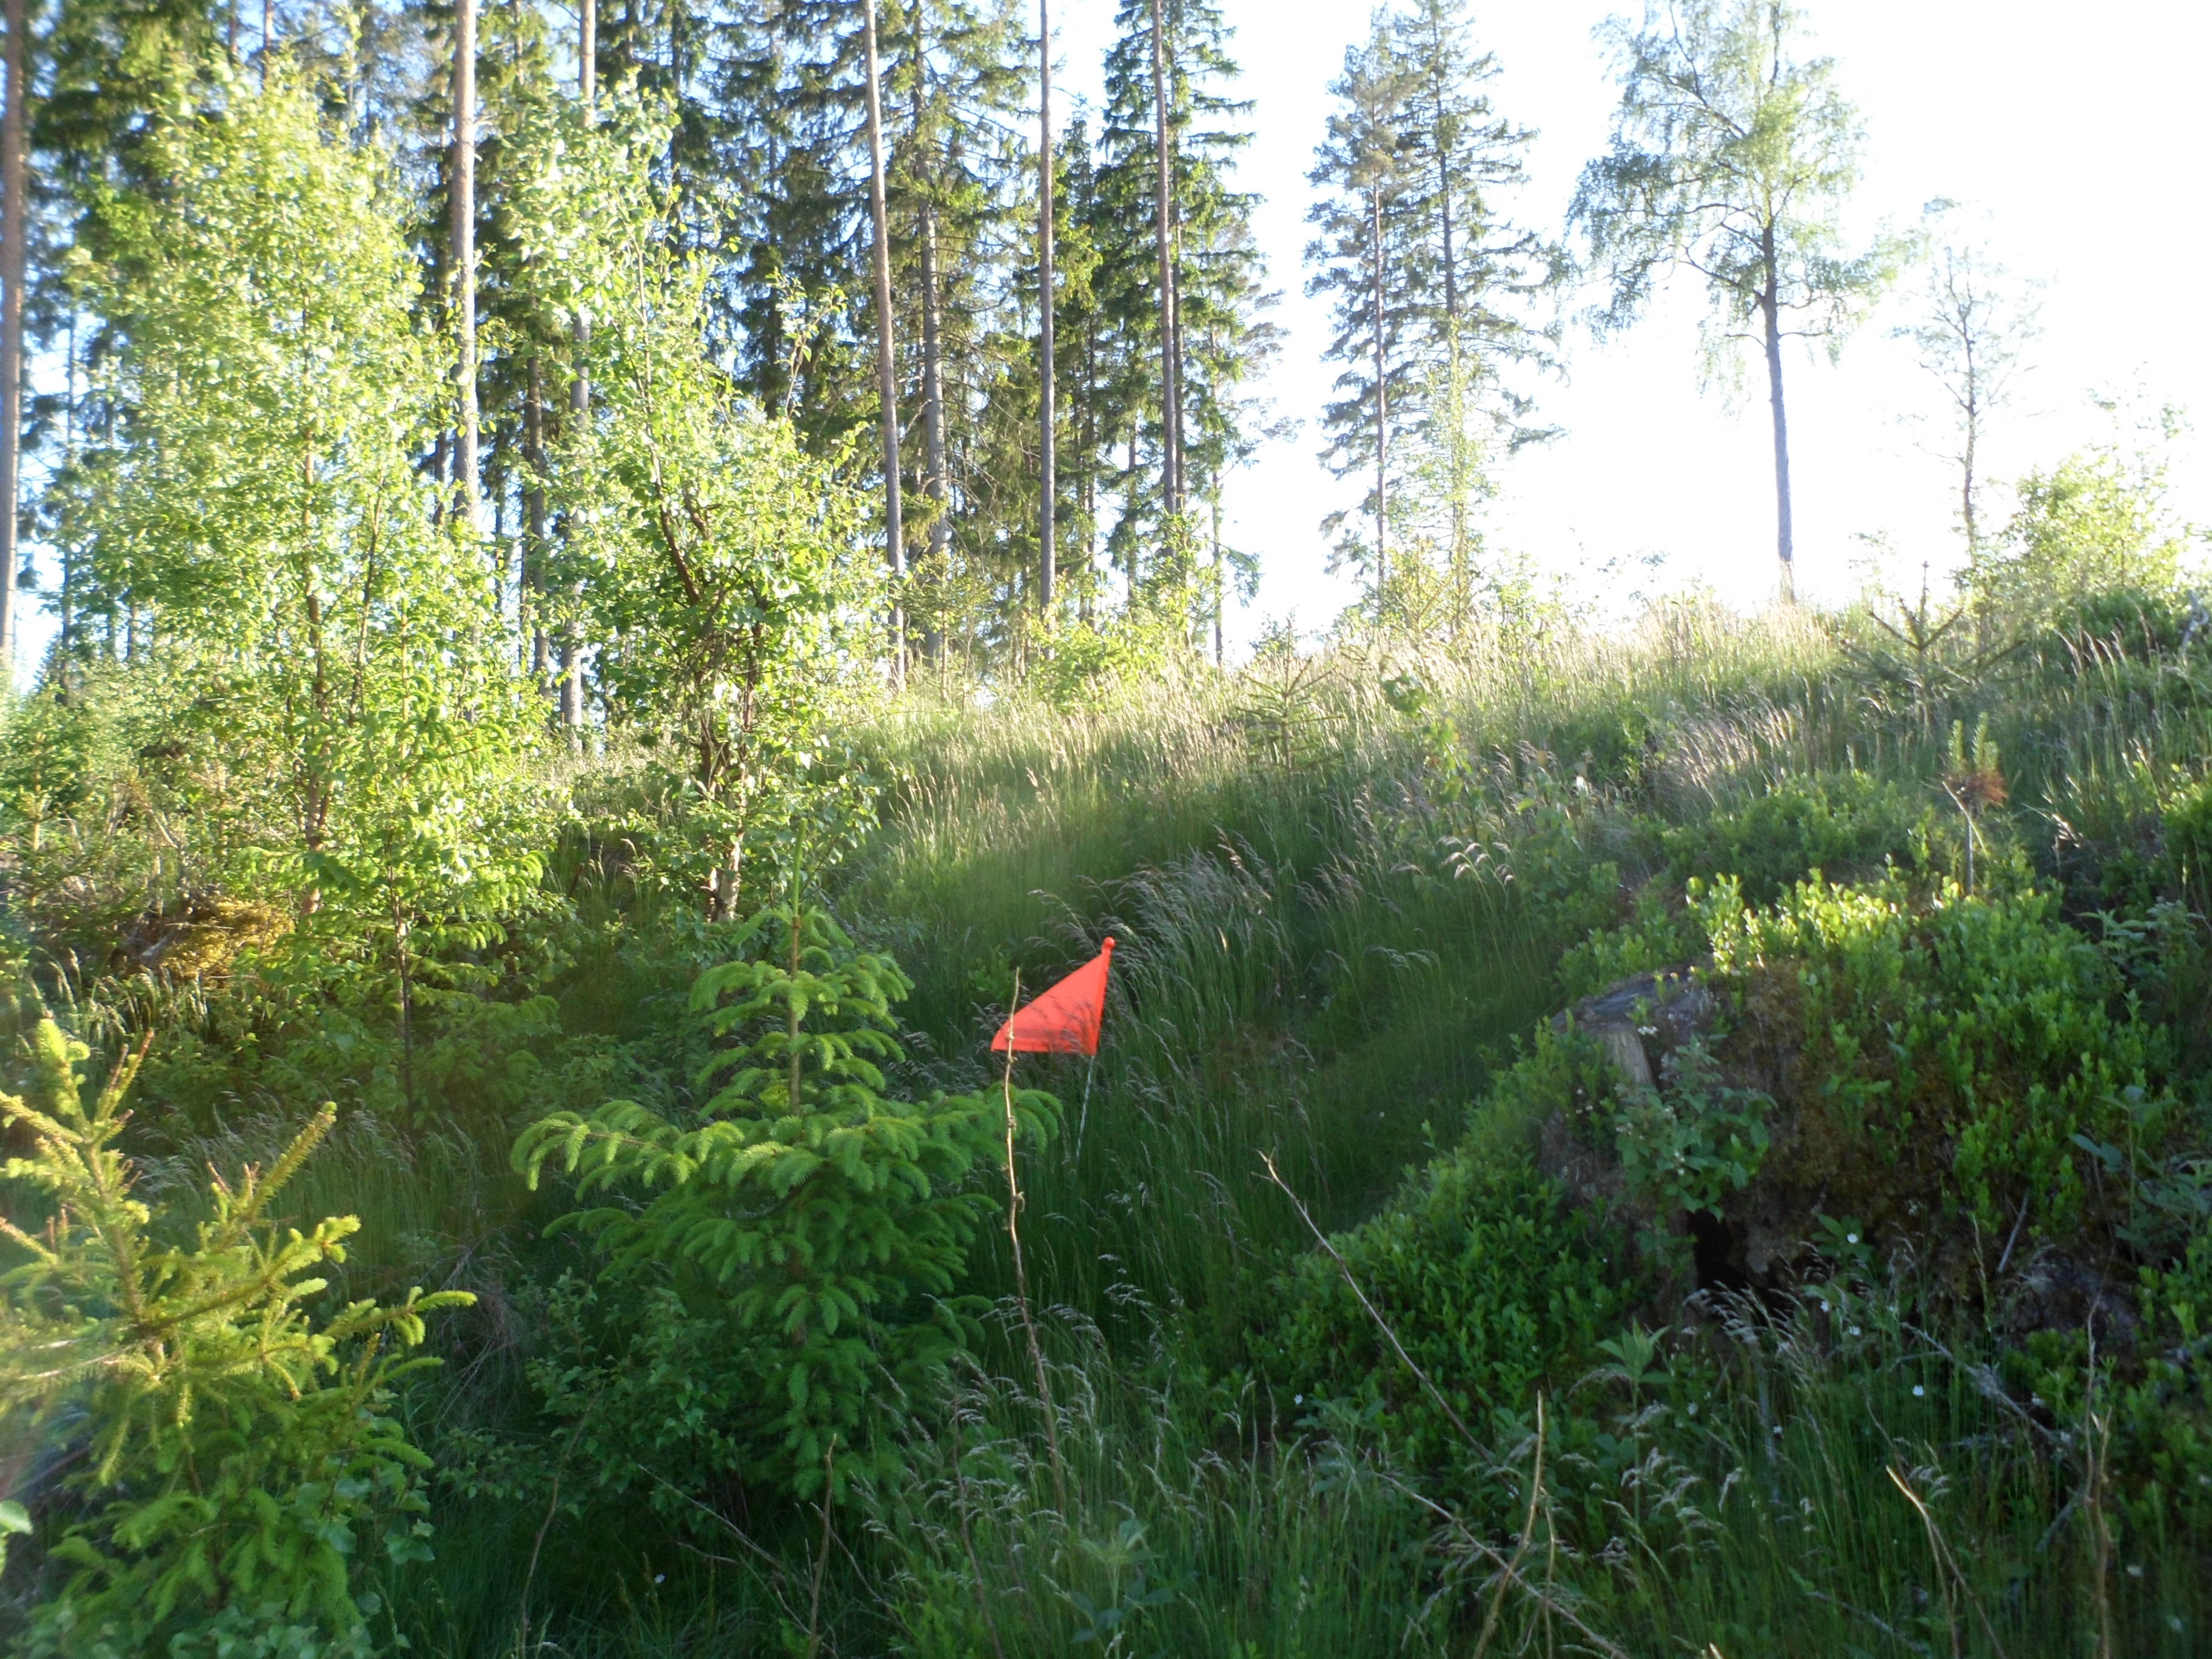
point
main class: Woodland
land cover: Spruce dominated mixed woodland
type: boreal forest
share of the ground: 50 - 75 %
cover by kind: coniferous forest trees 25 %, broadleaved forest trees 25 %, herbaceous plants 25 %, shrubs 20 %, lichens and mosses 5 %
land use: Forestry
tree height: < 5 m
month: June
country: SE
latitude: 57.4701
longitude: 14.1806
